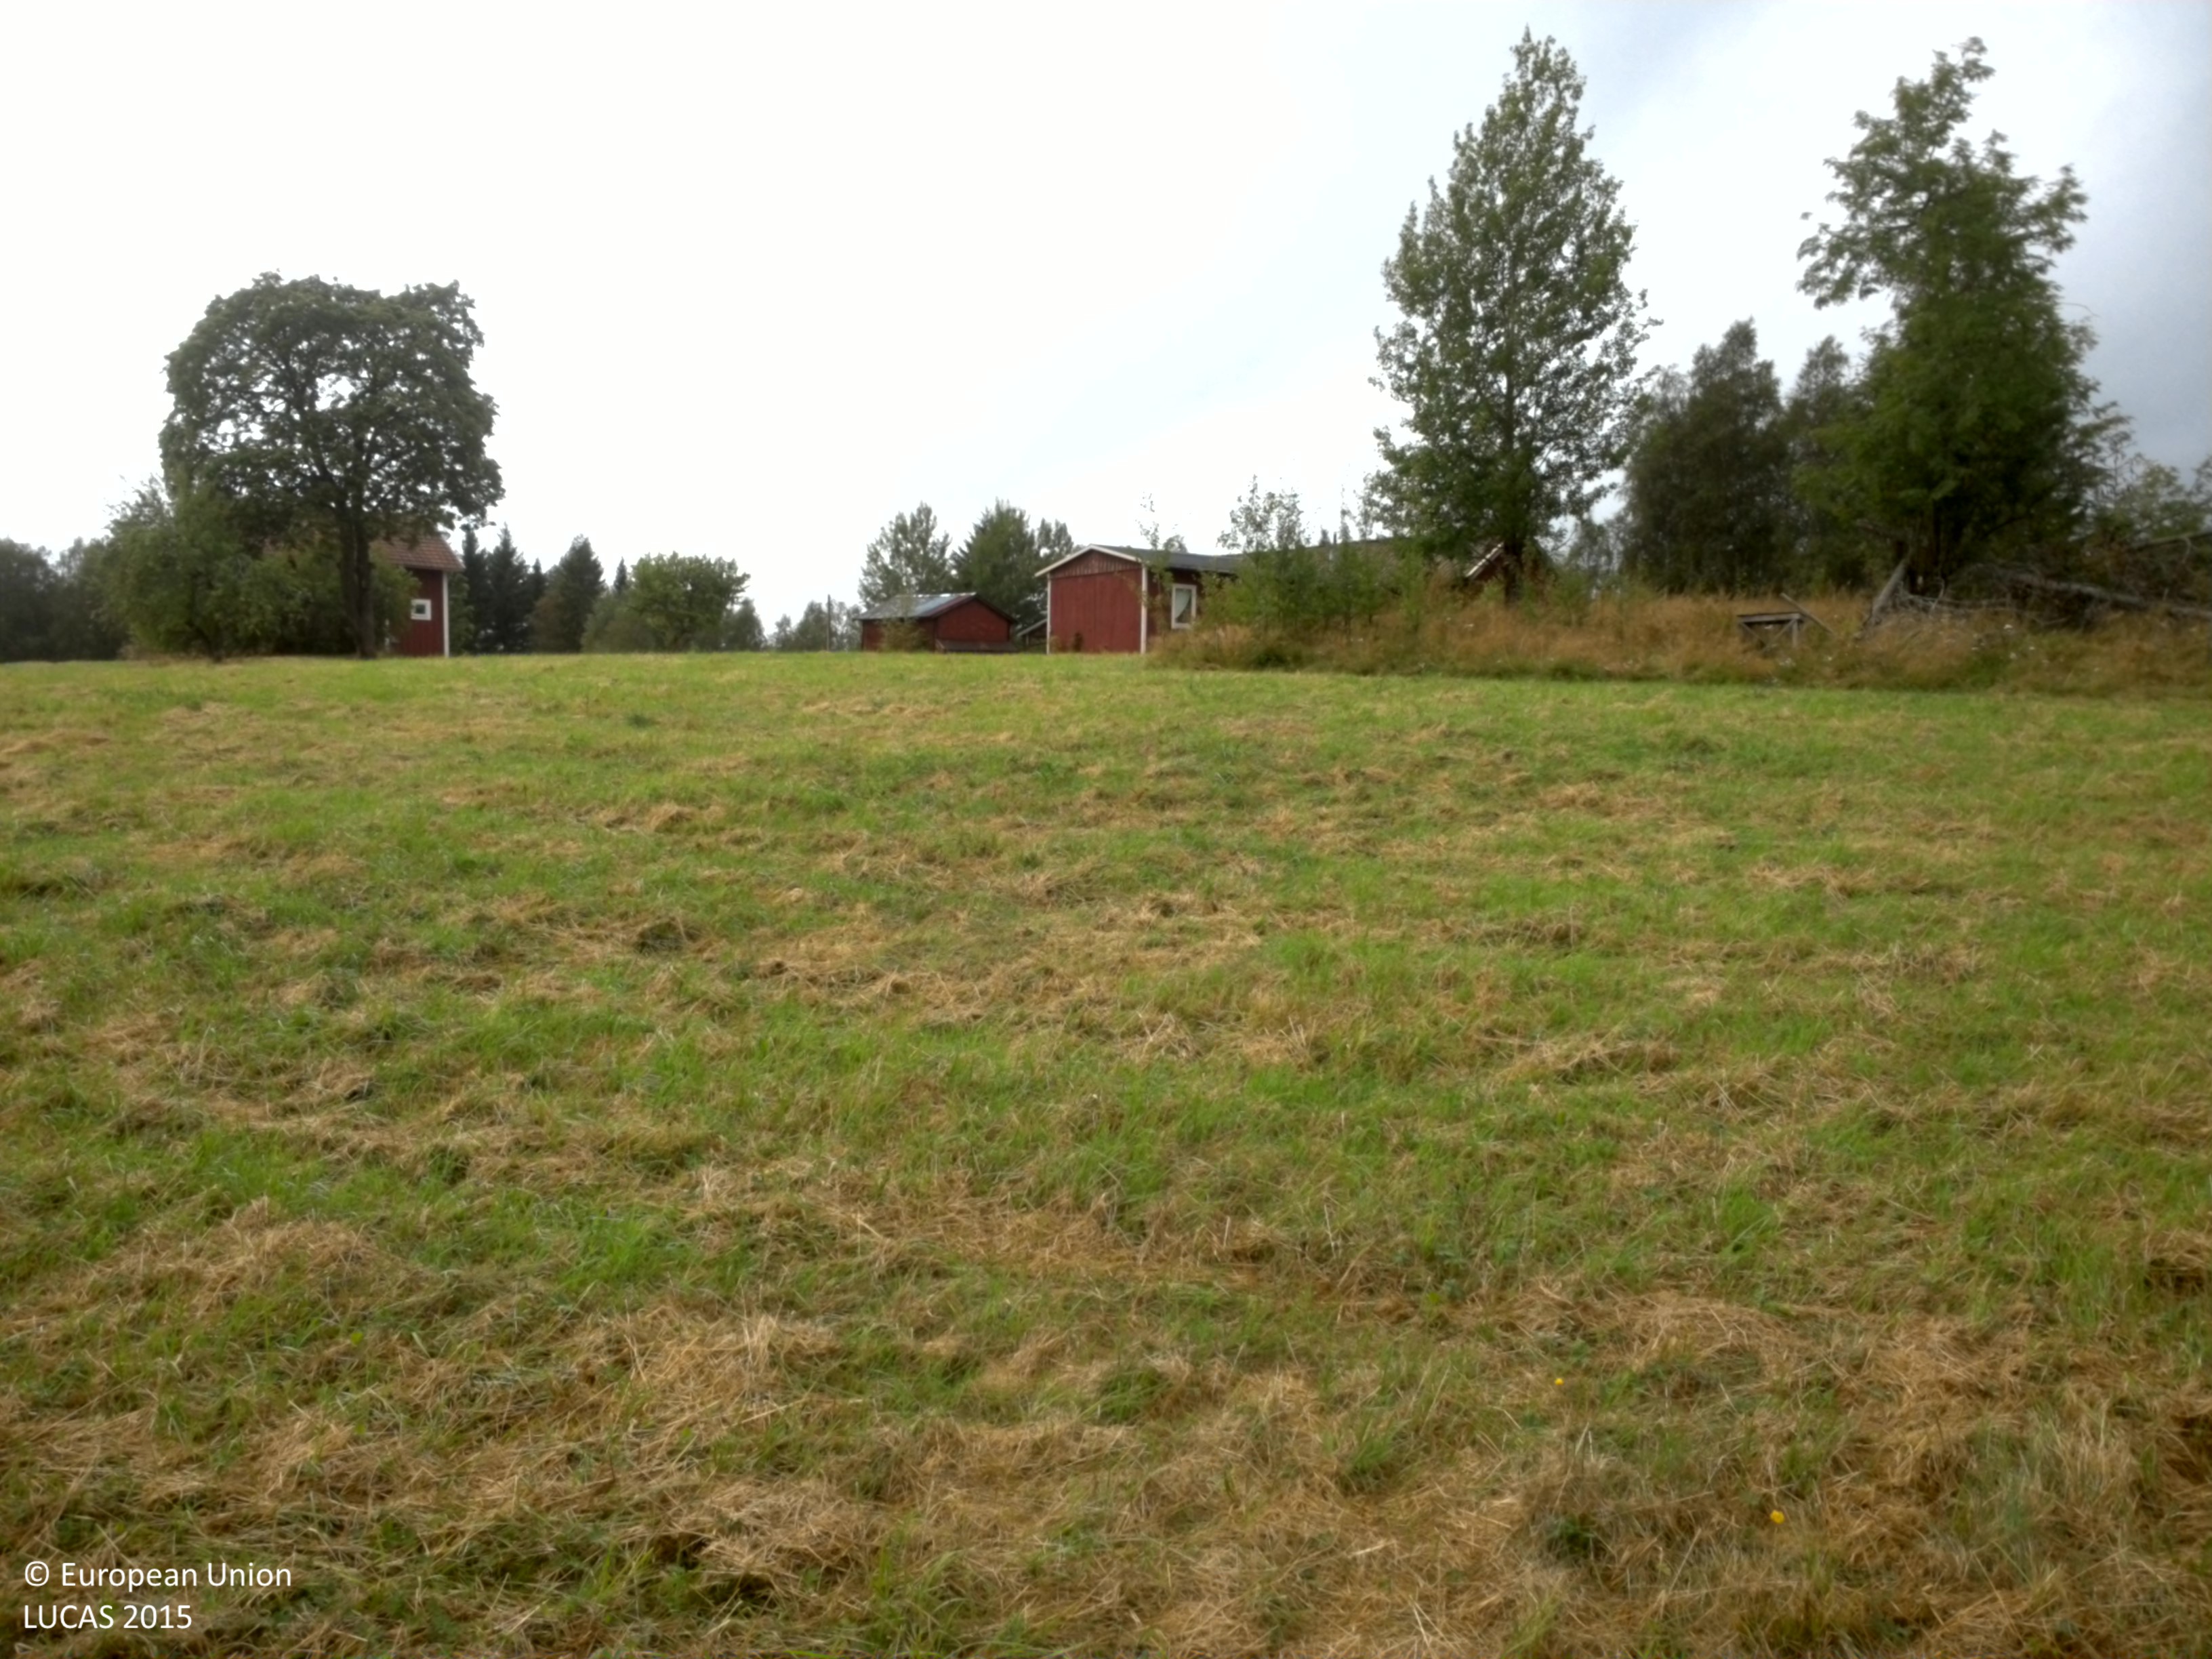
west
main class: Grassland
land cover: Grassland without tree/shrub cover
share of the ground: > 75 %
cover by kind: herbaceous plants 100 %
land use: Agriculture (excluding fallow land and kitchen gardens)
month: August
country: SE
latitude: 59.7807
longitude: 15.6012
